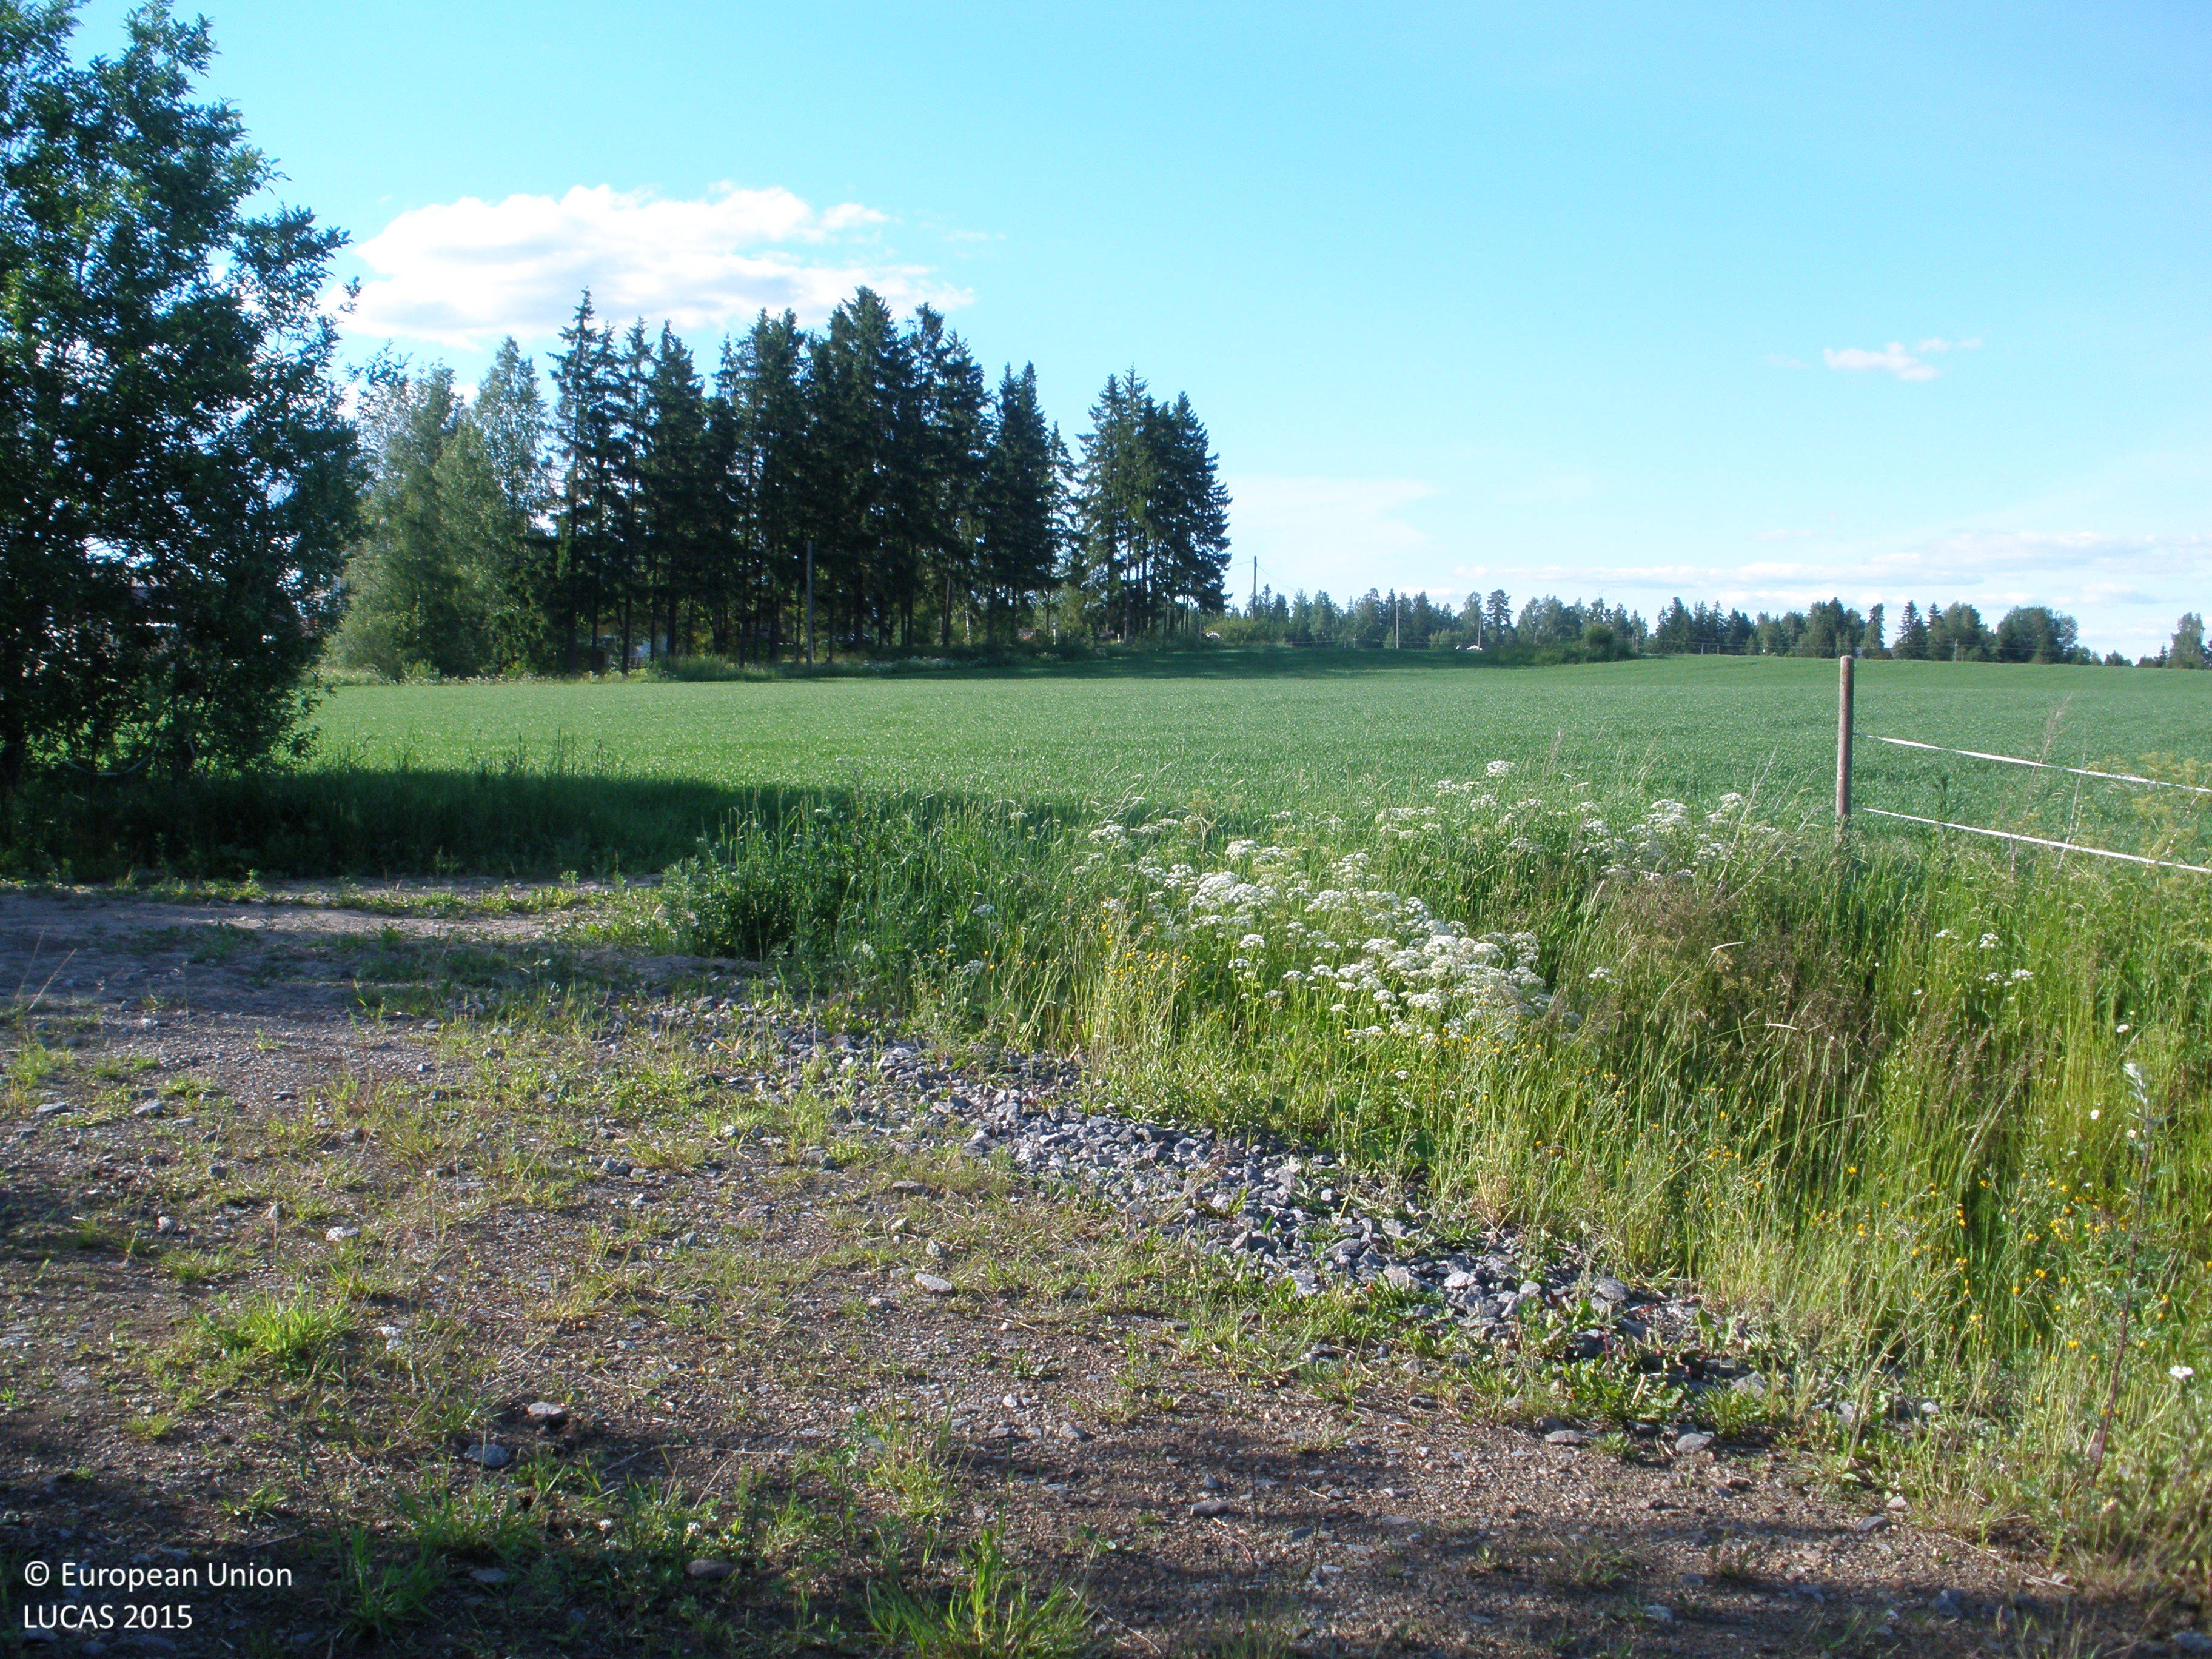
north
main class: Cropland
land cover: Common wheat
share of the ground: > 75 %
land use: Agriculture (excluding fallow land and kitchen gardens)
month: July
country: FI
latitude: 61.1704
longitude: 23.9399
